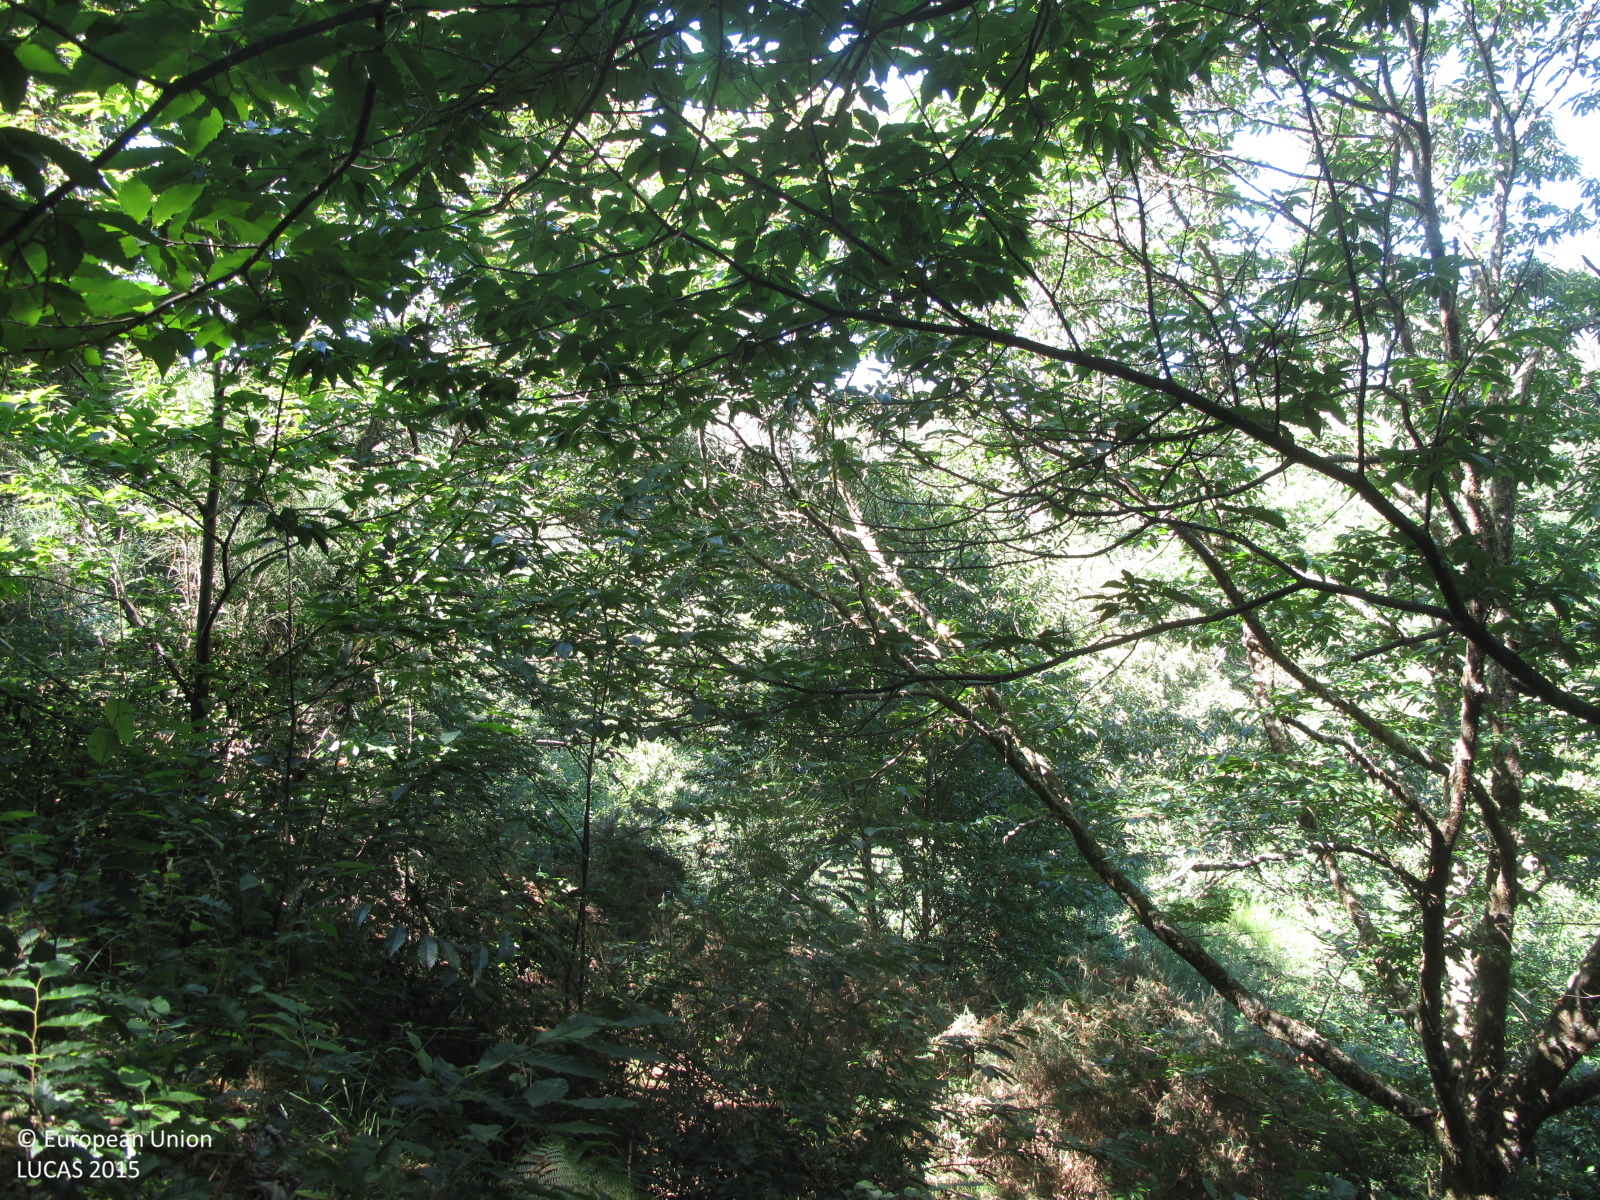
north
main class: Woodland
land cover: Broadleaved woodland
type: thermophilous deciduous forest
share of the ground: > 75 %
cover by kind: broadleaved forest trees 100 %
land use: Forestry
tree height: > 5 m
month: July
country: ES
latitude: 43.3213
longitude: -8.1640
